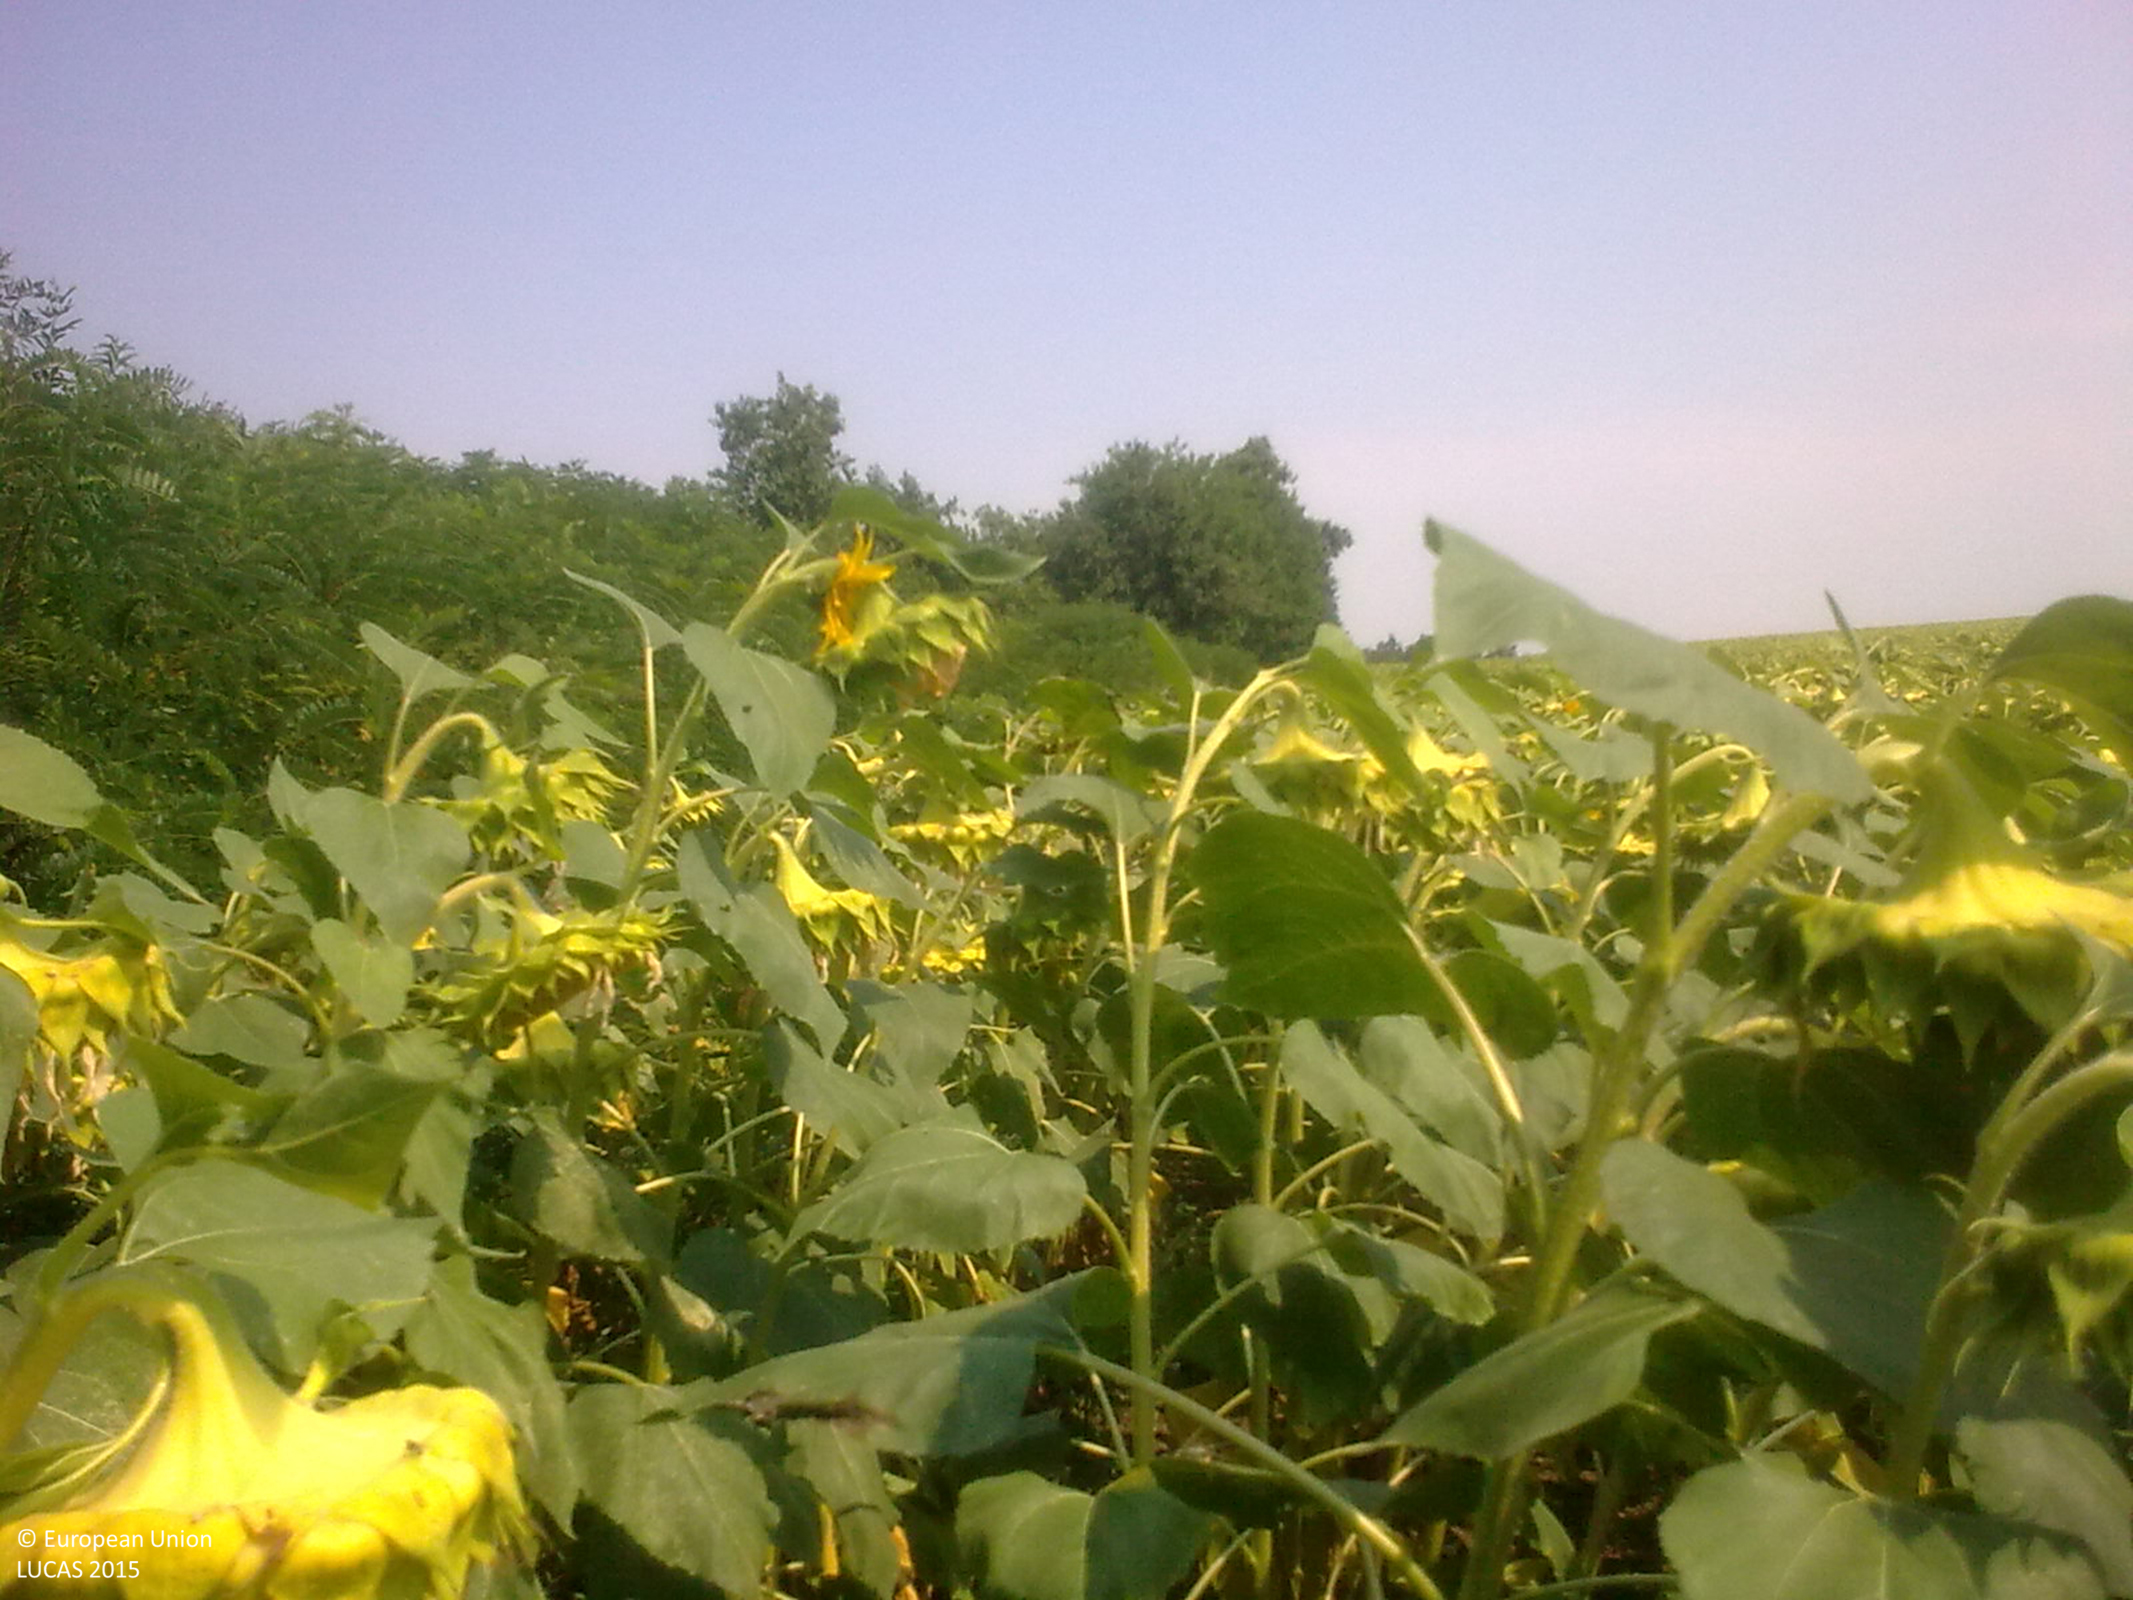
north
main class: Cropland
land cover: Sunflower
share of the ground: > 75 %
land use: Agriculture (excluding fallow land and kitchen gardens)
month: July
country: BG
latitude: 43.7004
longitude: 25.9139
